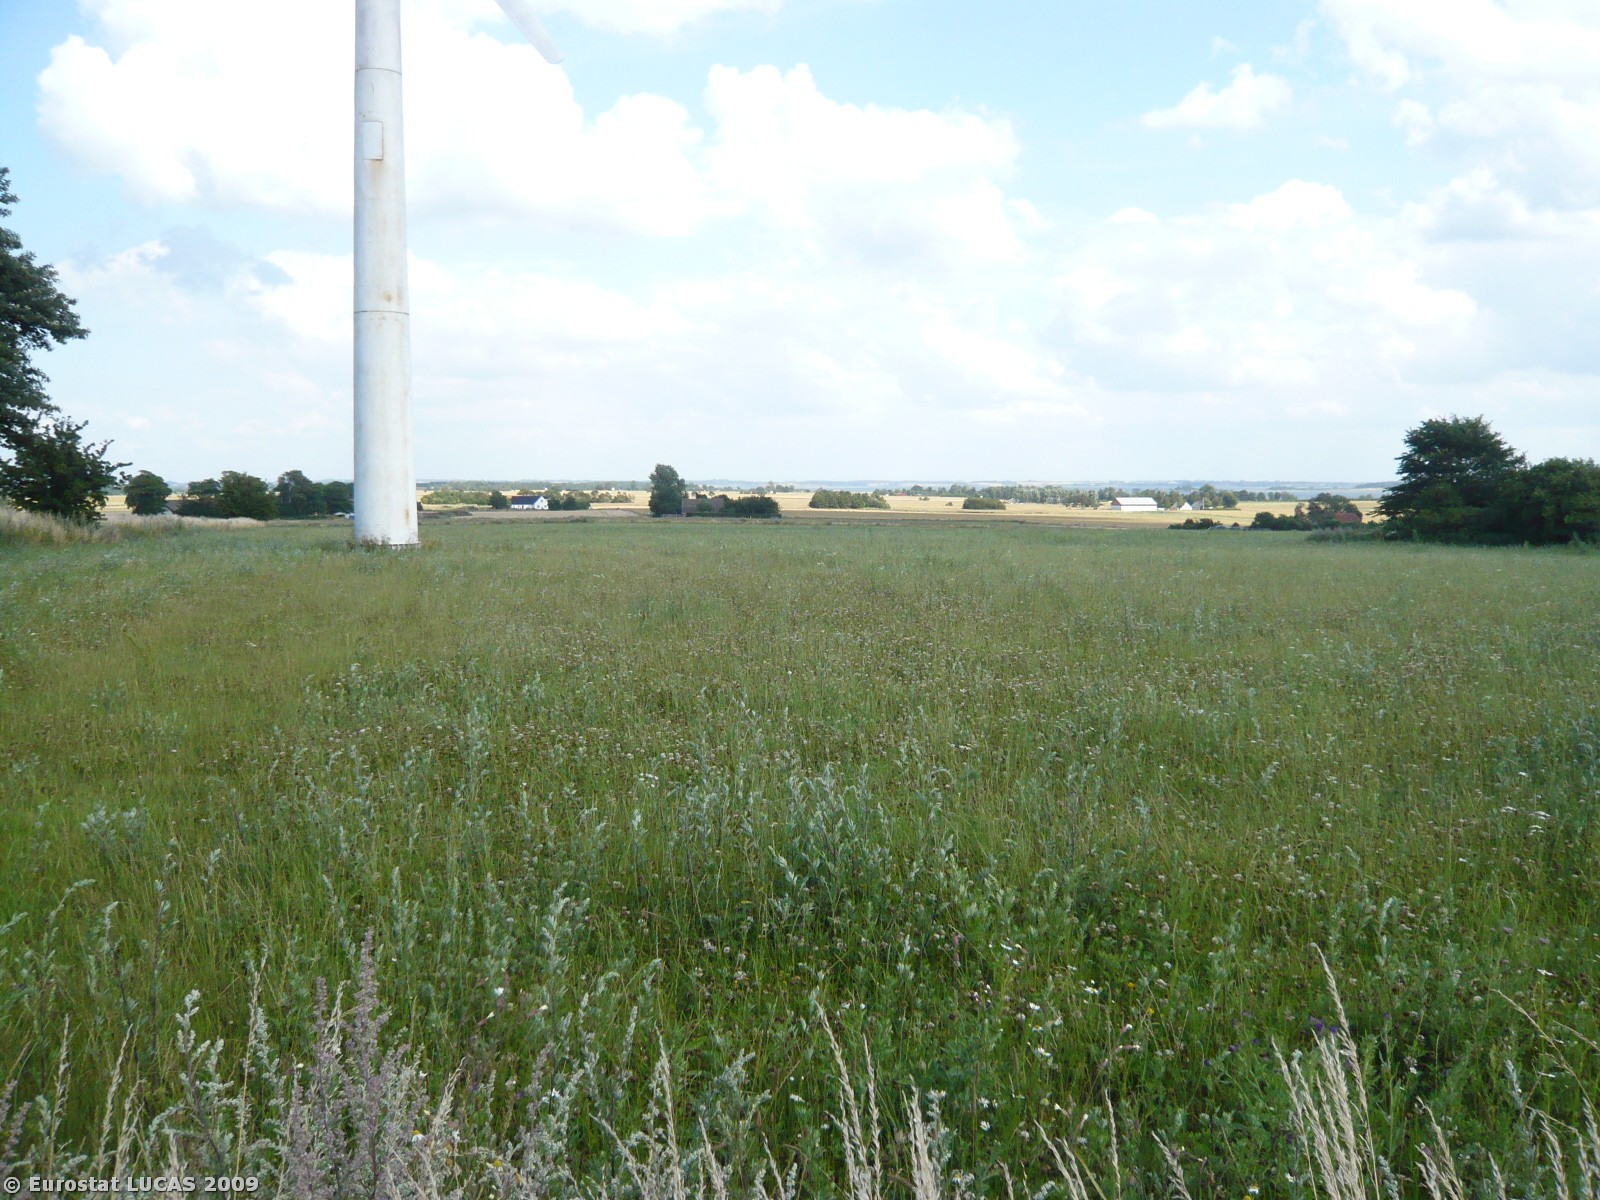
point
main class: Grassland
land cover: Grassland without tree/shrub cover
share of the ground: > 75 %
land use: Agriculture (excluding fallow land and kitchen gardens)
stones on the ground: < 10 %
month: July
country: DK
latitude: 55.7450
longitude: 11.7029
